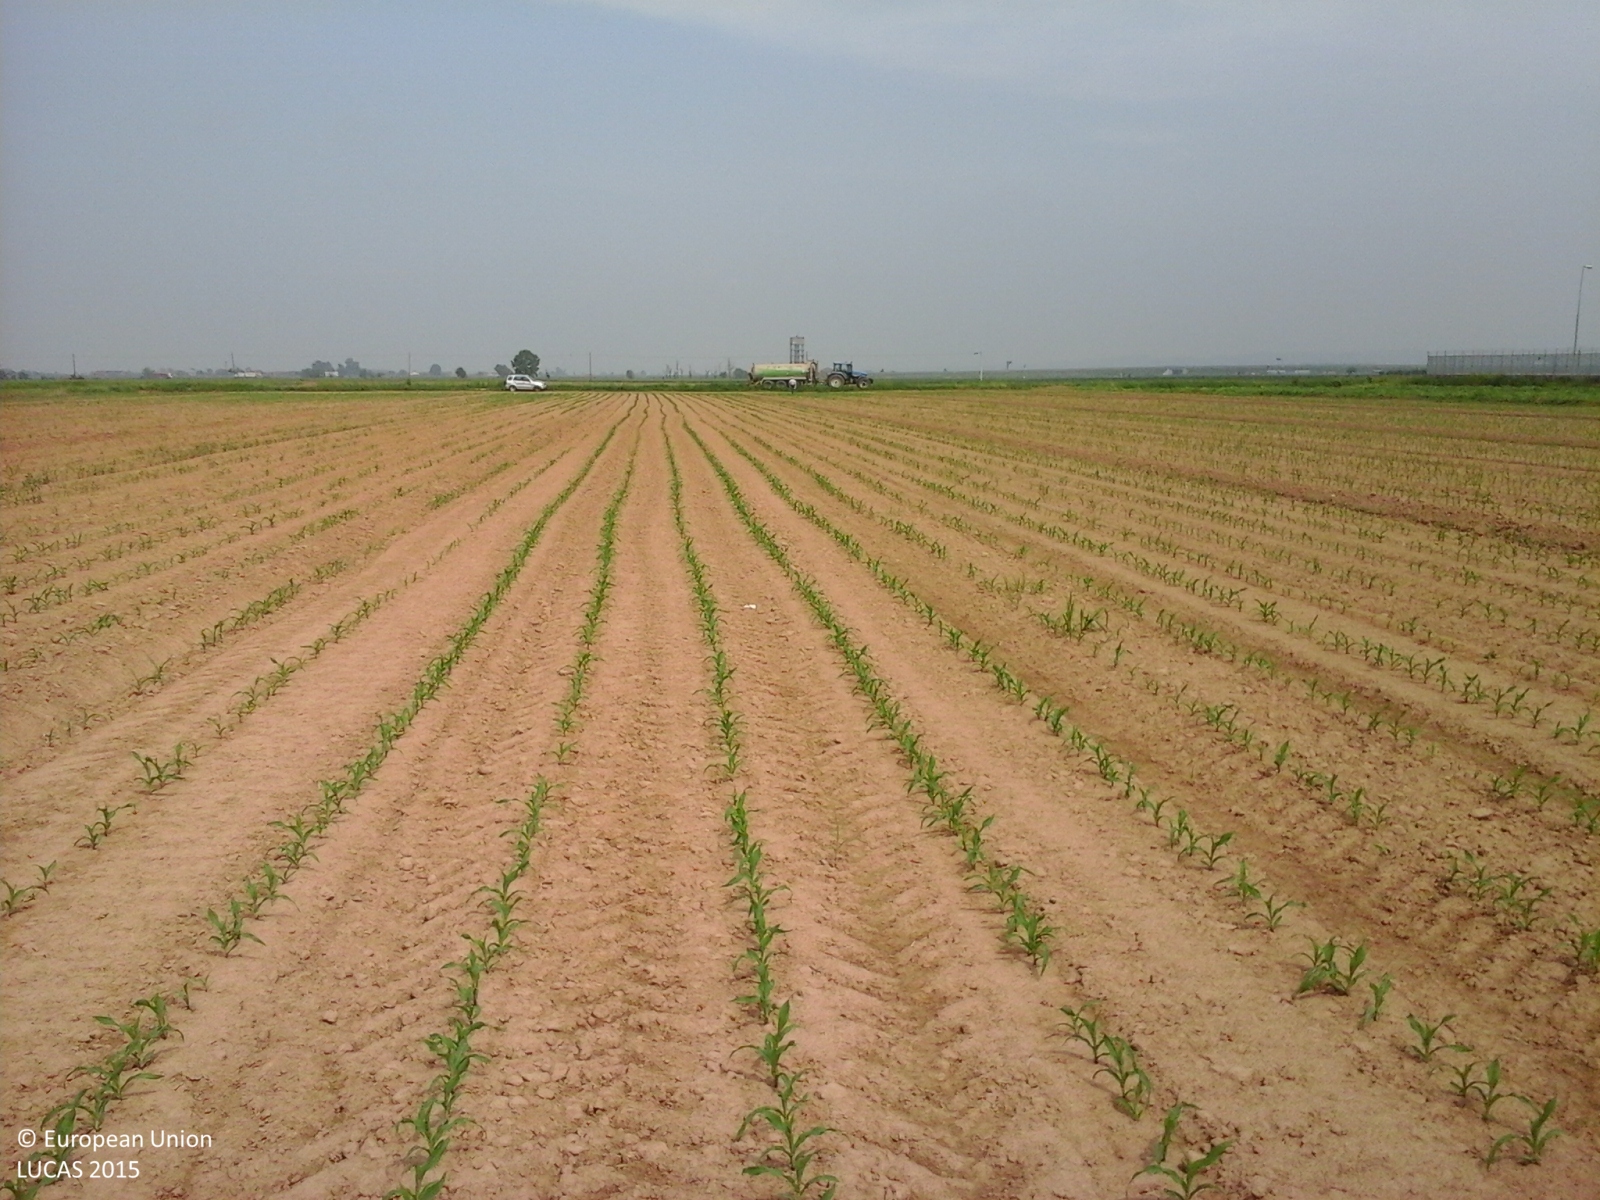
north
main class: Cropland
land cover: Maize
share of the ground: < 10 %
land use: Agriculture (excluding fallow land and kitchen gardens)
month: May
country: IT
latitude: 44.6519
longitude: 7.7977
